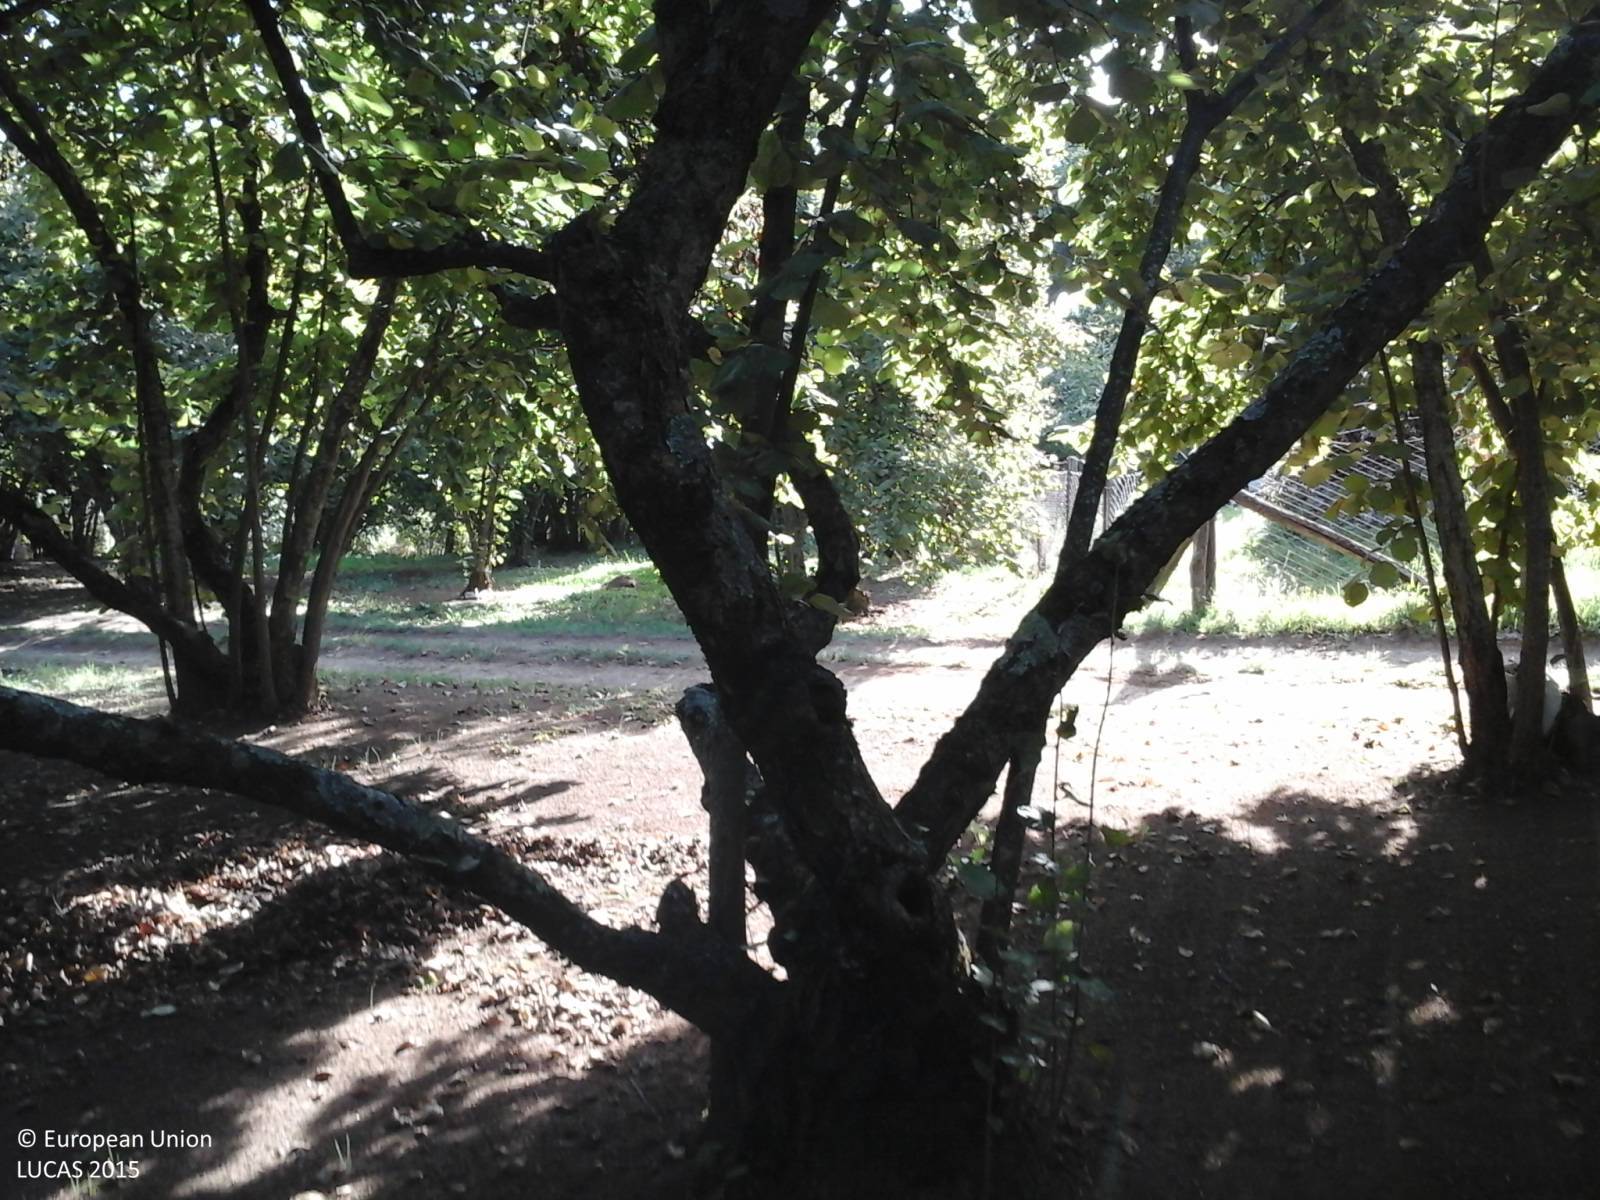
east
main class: Cropland
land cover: Nuts trees
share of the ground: > 75 %
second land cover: Grassland without tree/shrub cover
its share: > 75 %
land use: Agriculture (excluding fallow land and kitchen gardens)
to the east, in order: Nuts trees; Grassland without tree/shrub cover; Tracks; Nuts trees; Grass margins; Nuts trees
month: September
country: IT
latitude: 42.3938
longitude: 12.2639
